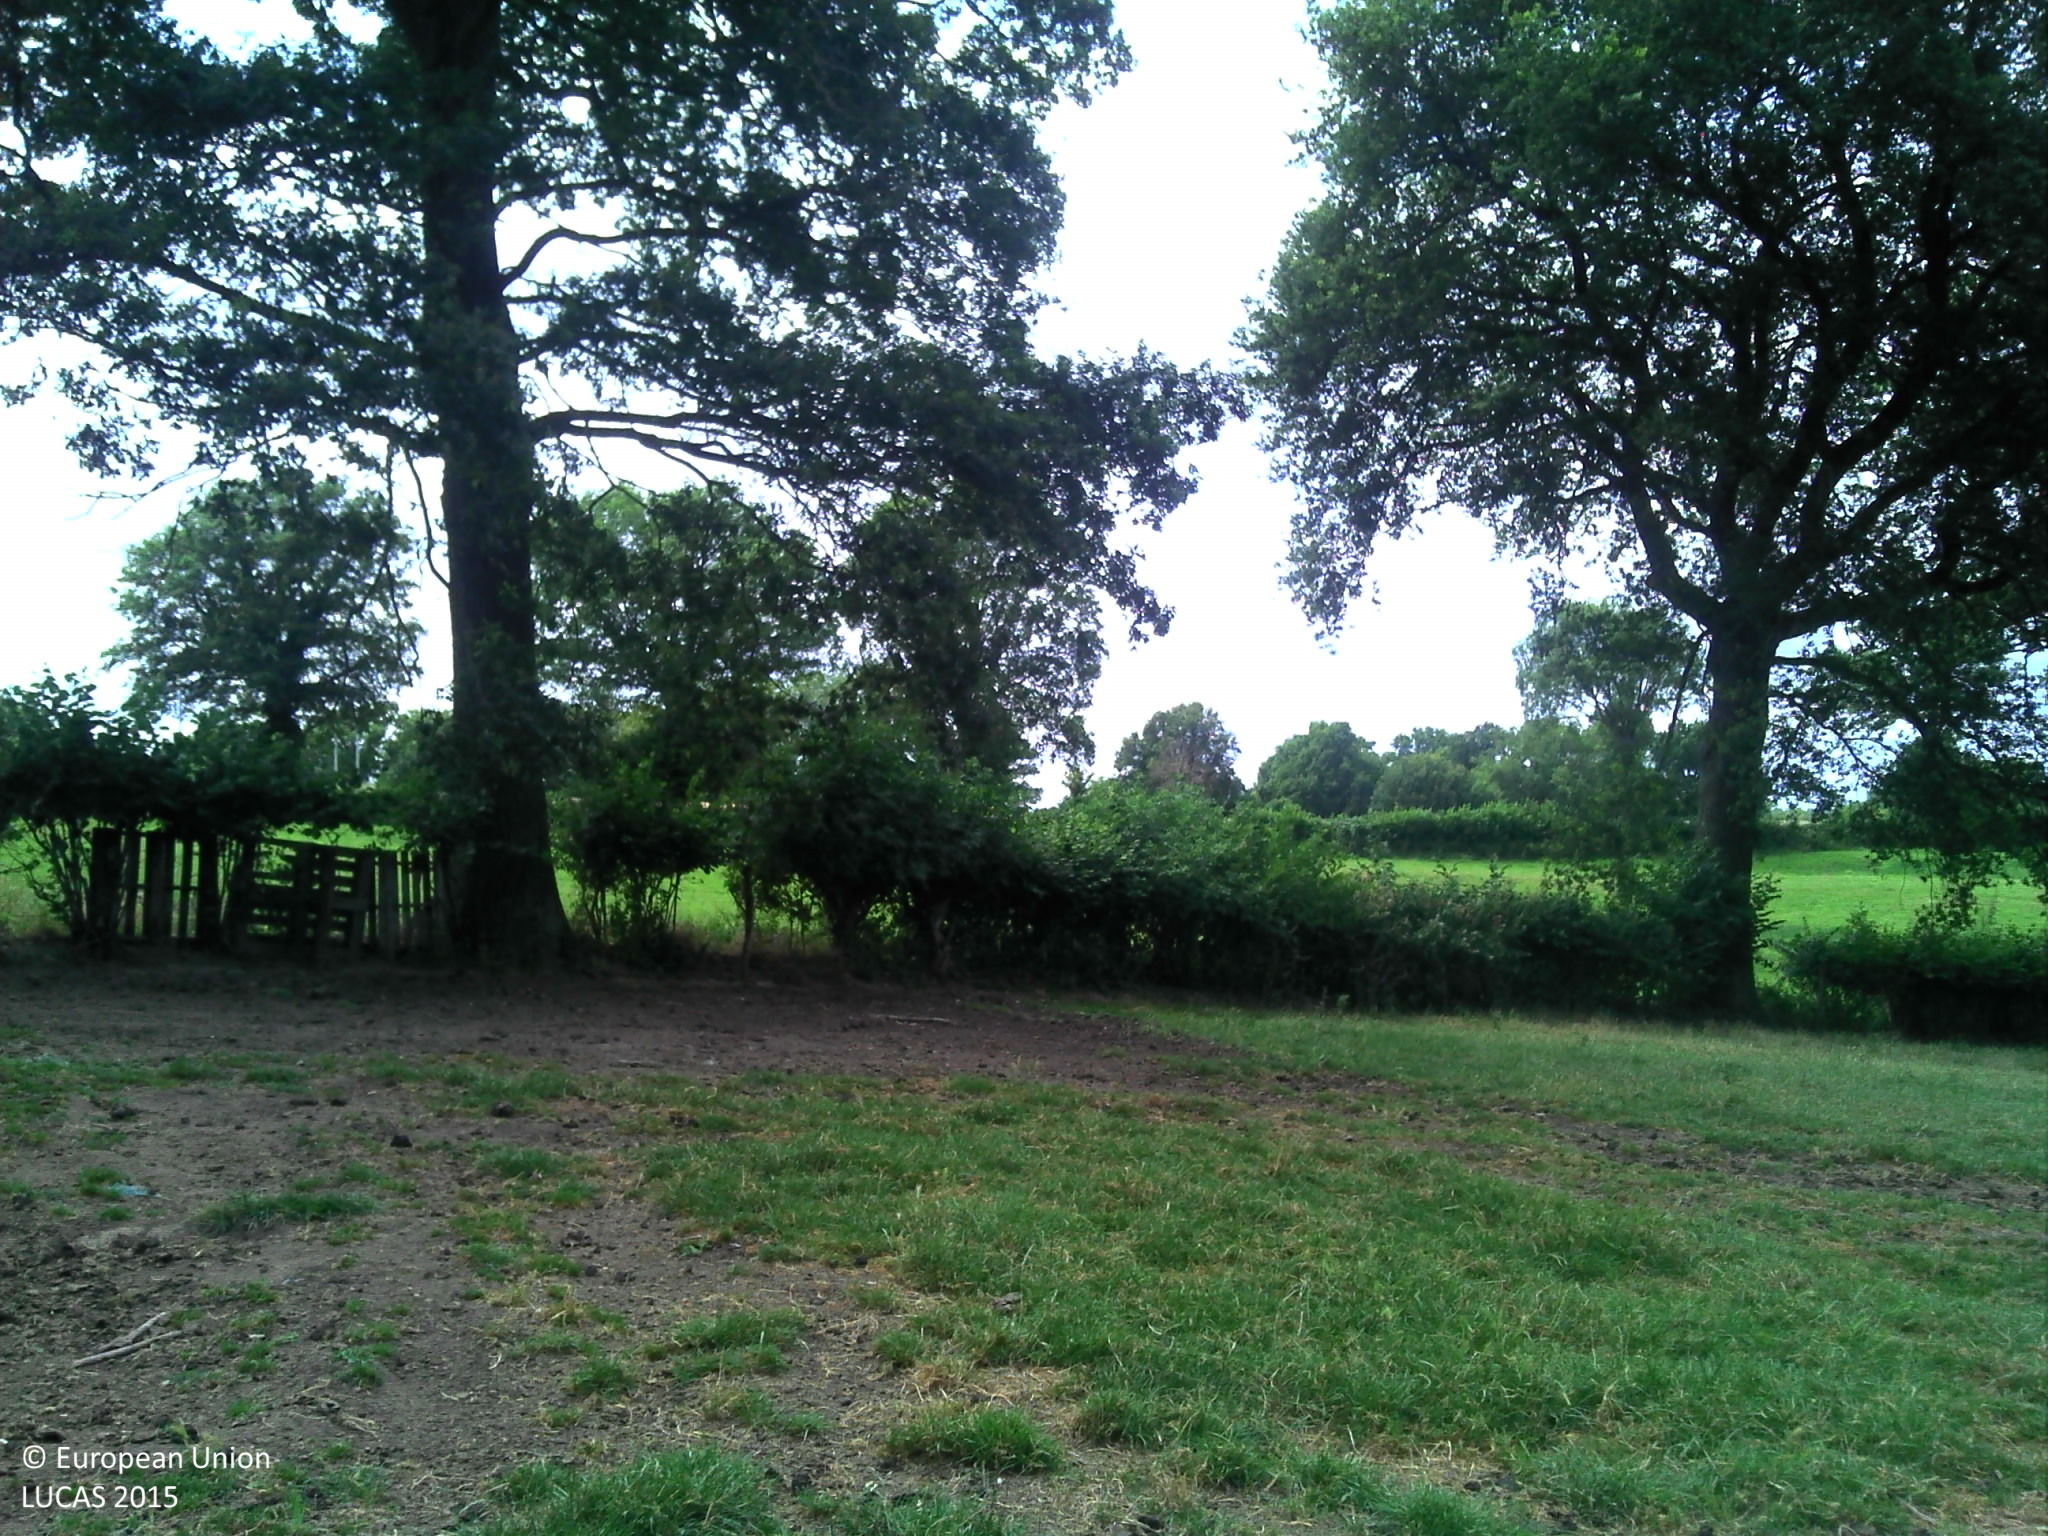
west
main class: Grassland
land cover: Grassland without tree/shrub cover
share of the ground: > 75 %
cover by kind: herbaceous plants 95 %, shrubs 5 %
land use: Agriculture (excluding fallow land and kitchen gardens)
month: July
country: FR
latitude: 46.4117
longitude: 3.0115
